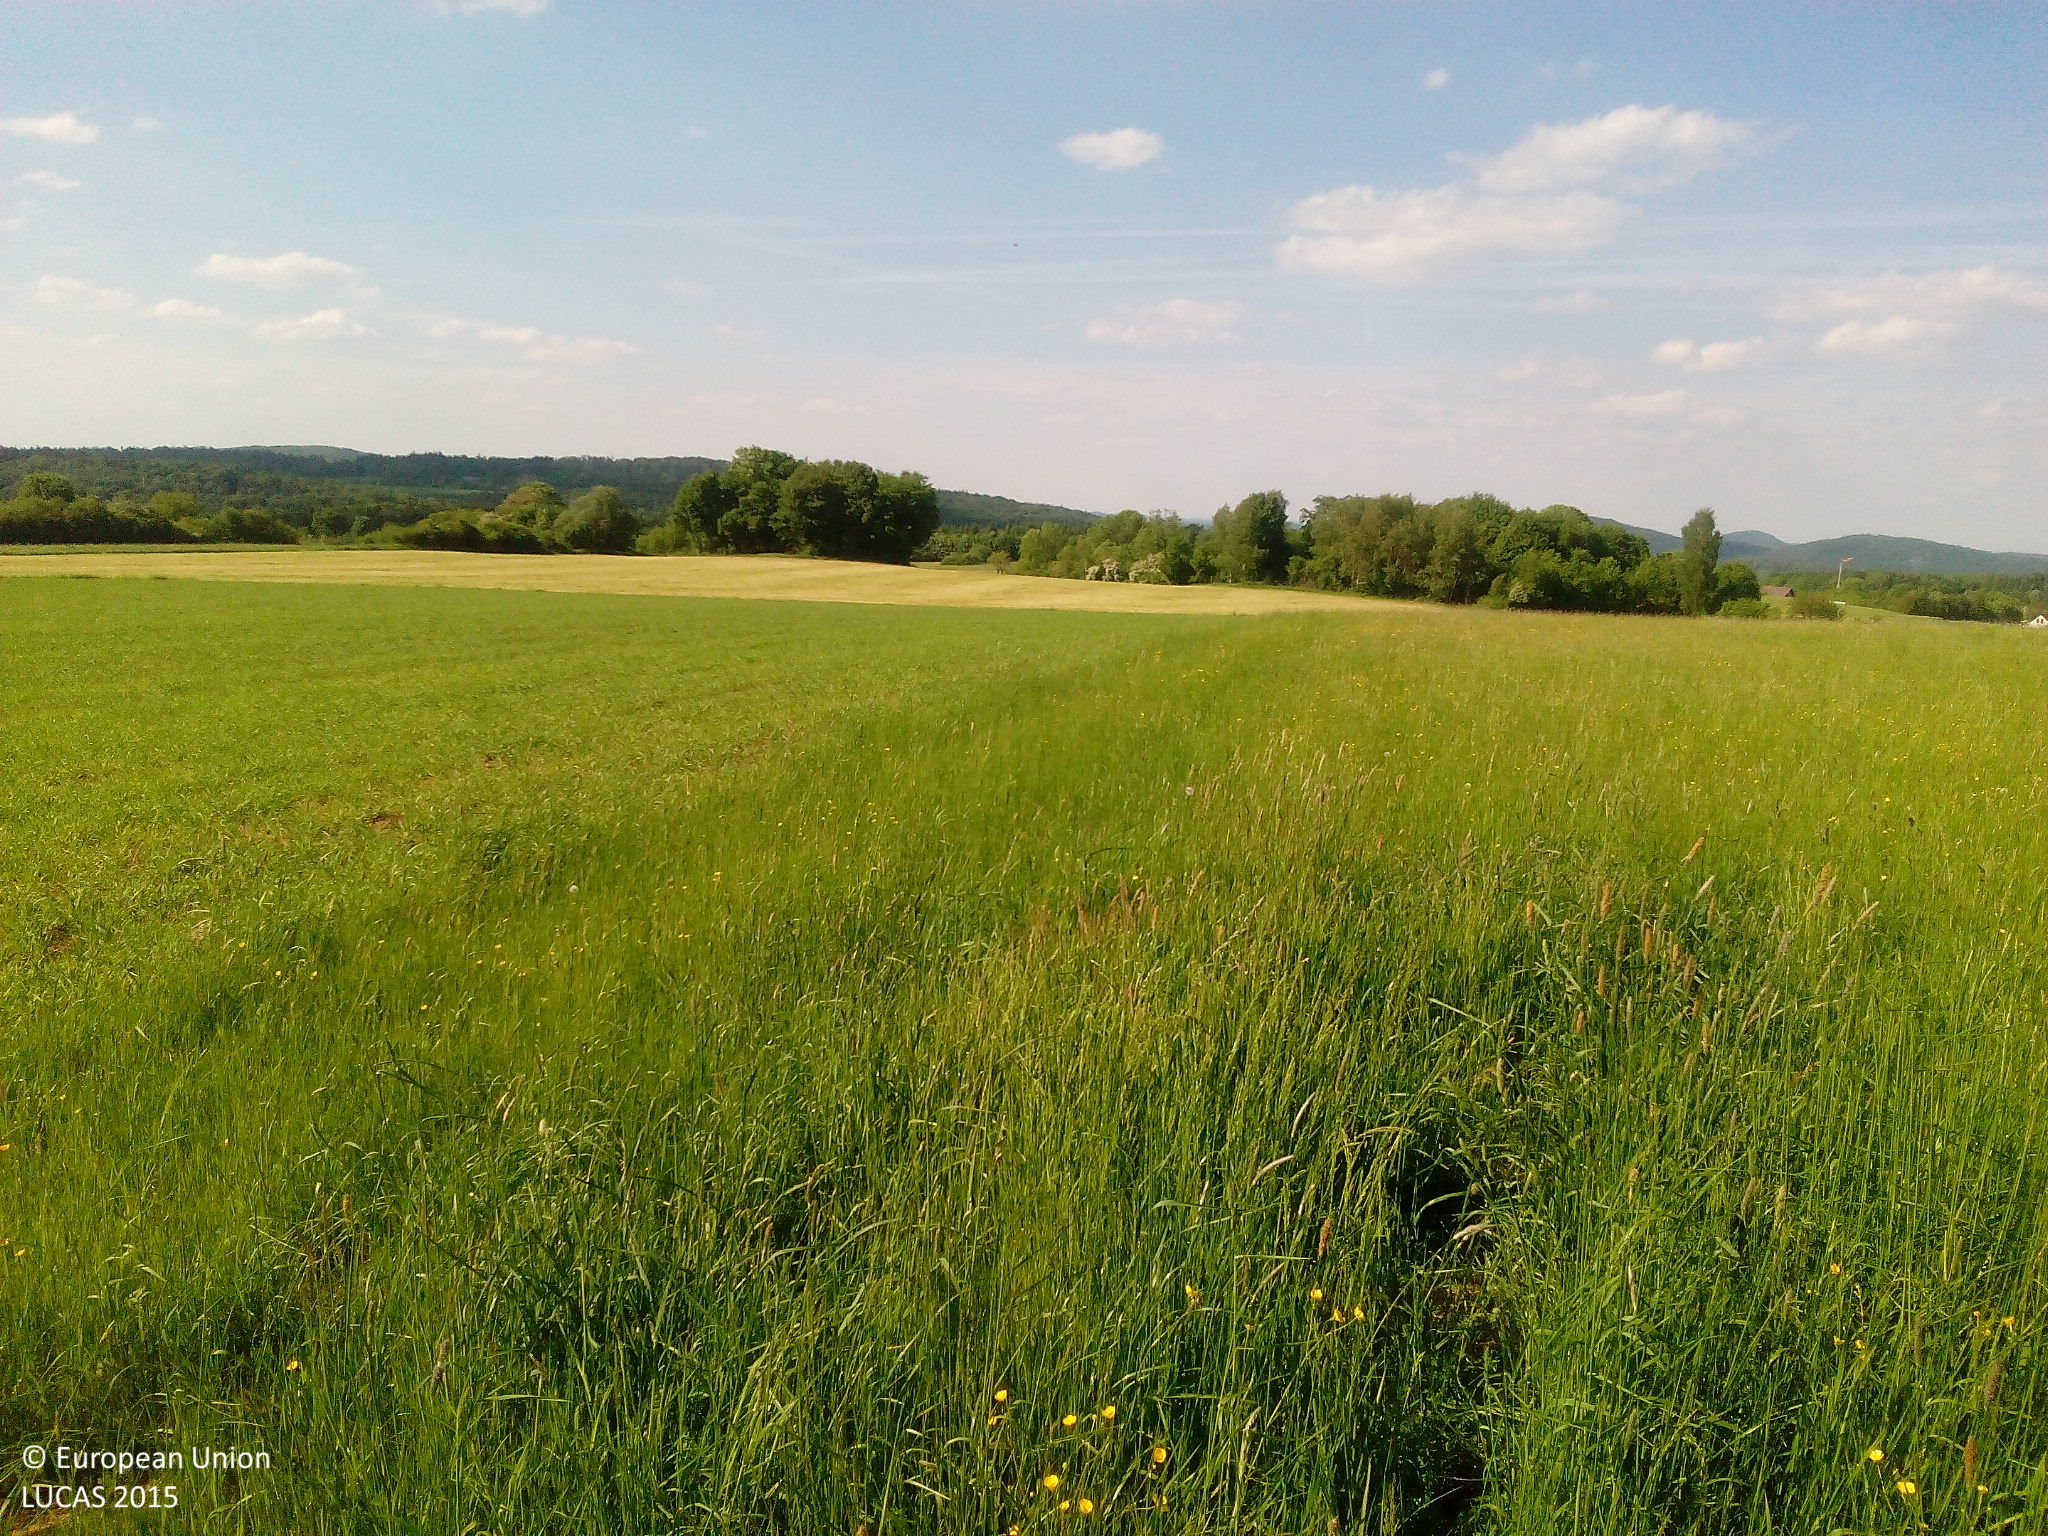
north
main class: Grassland
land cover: Grassland without tree/shrub cover
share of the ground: > 75 %
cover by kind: herbaceous plants 100 %
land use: Agriculture (excluding fallow land and kitchen gardens)
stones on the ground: < 10 %
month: May
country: DE
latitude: 49.4372
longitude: 11.4751
